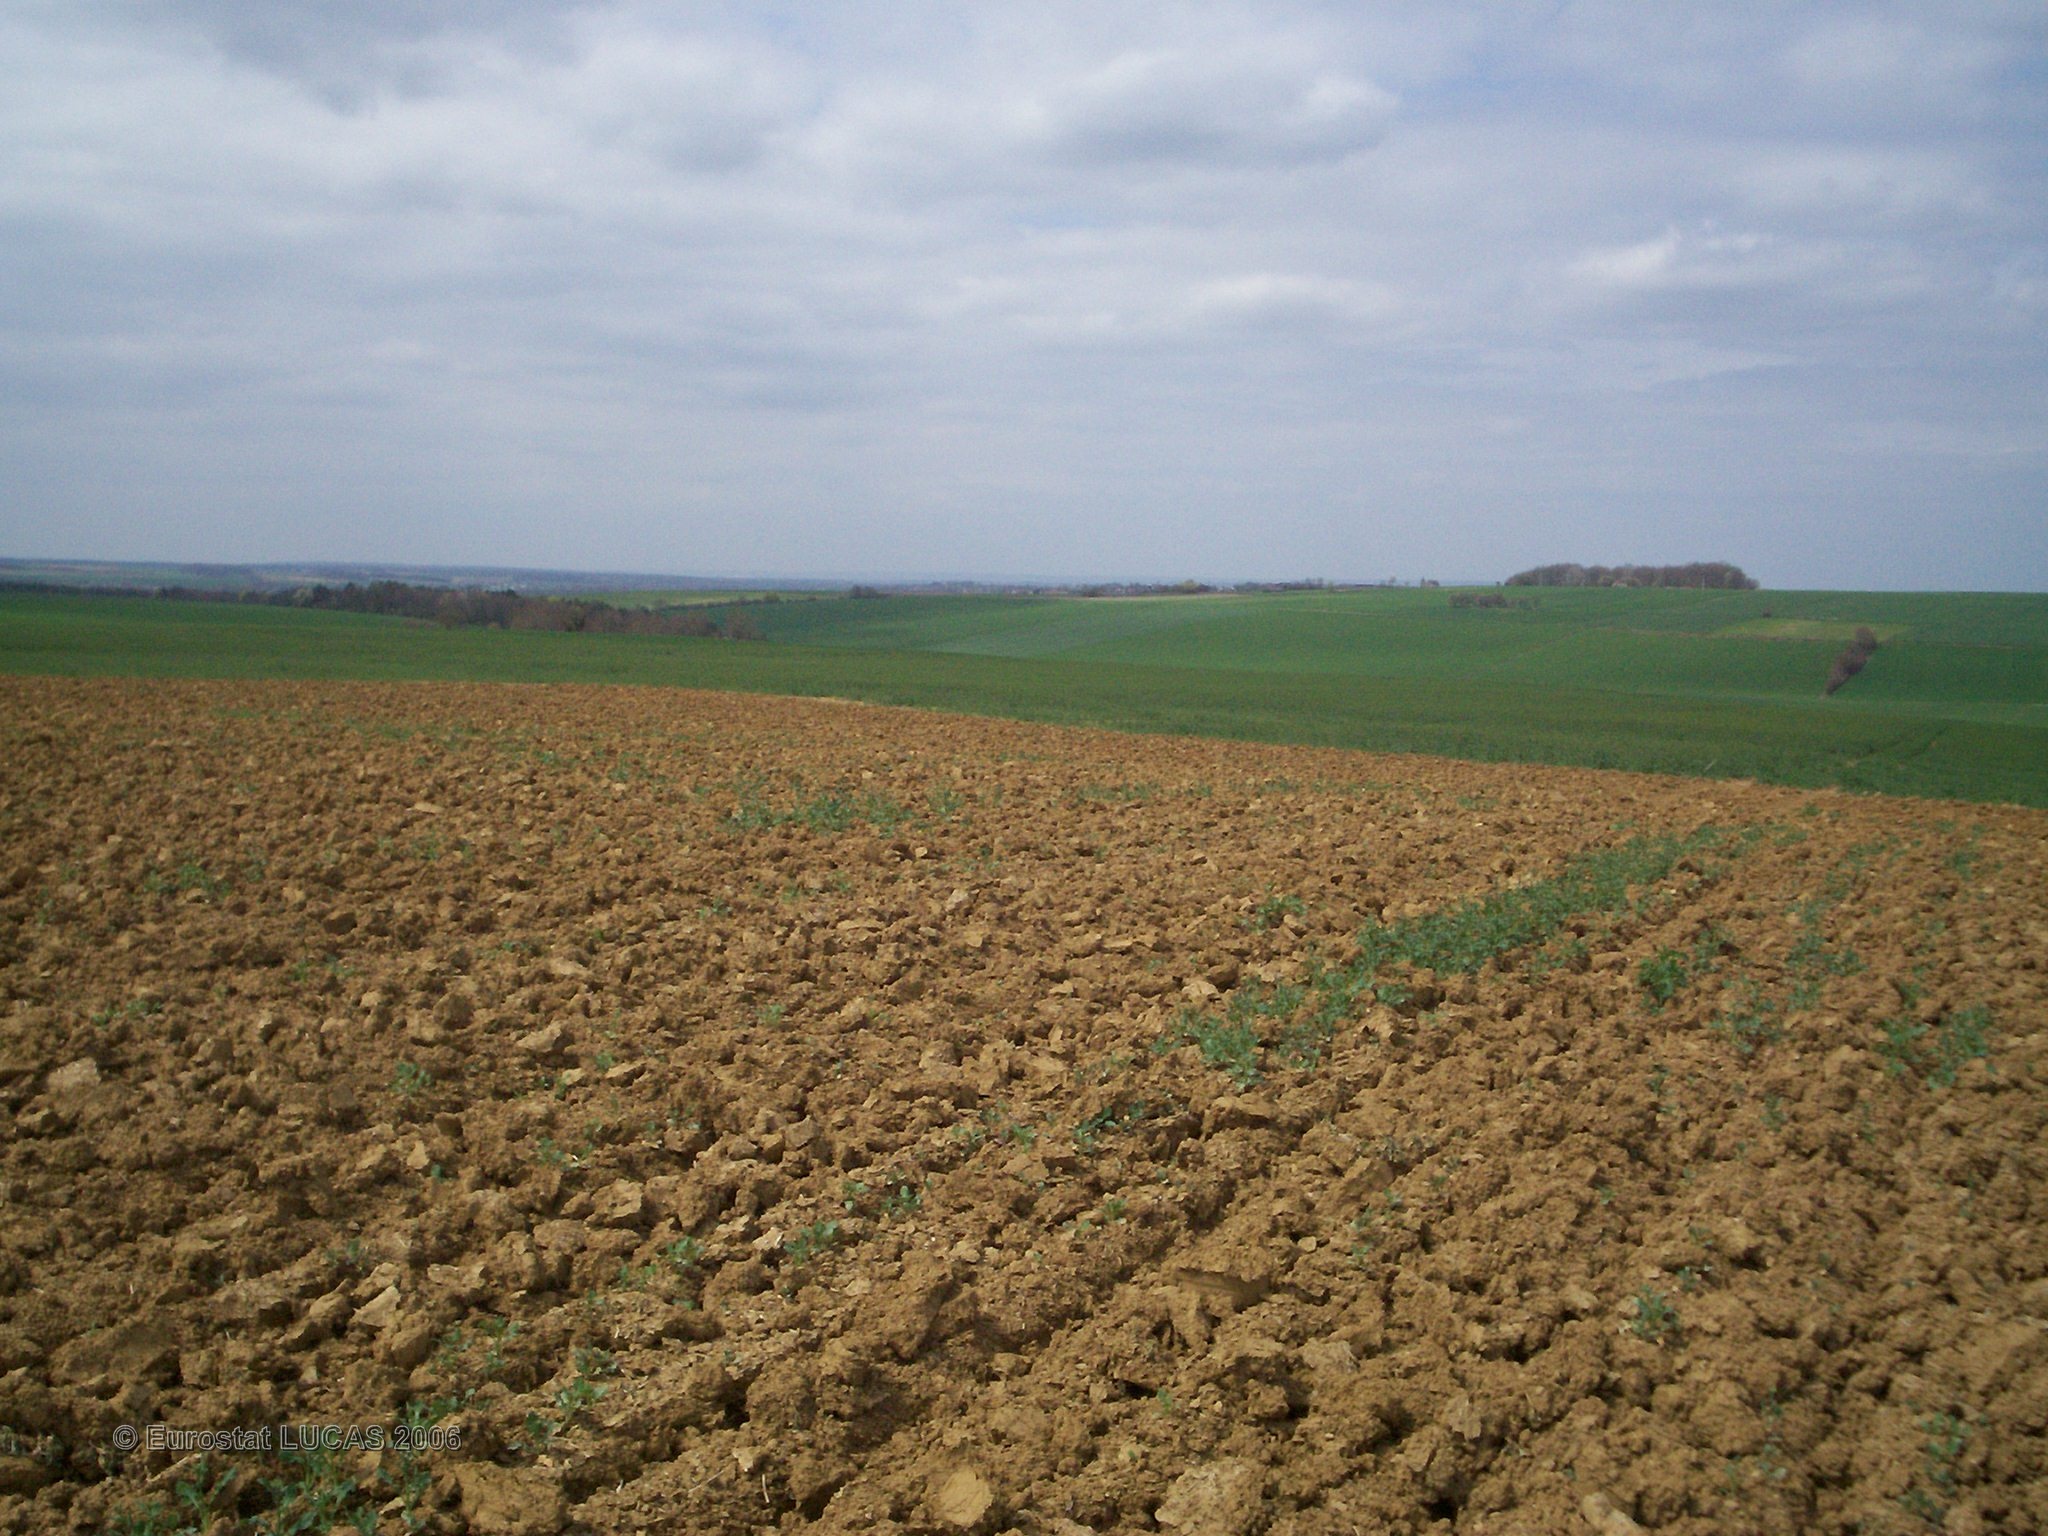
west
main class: Cropland
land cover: Rape and turnip rape
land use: Agriculture (excluding fallow land and kitchen gardens)
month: May
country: FR
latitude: 47.9316
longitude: 3.9601
